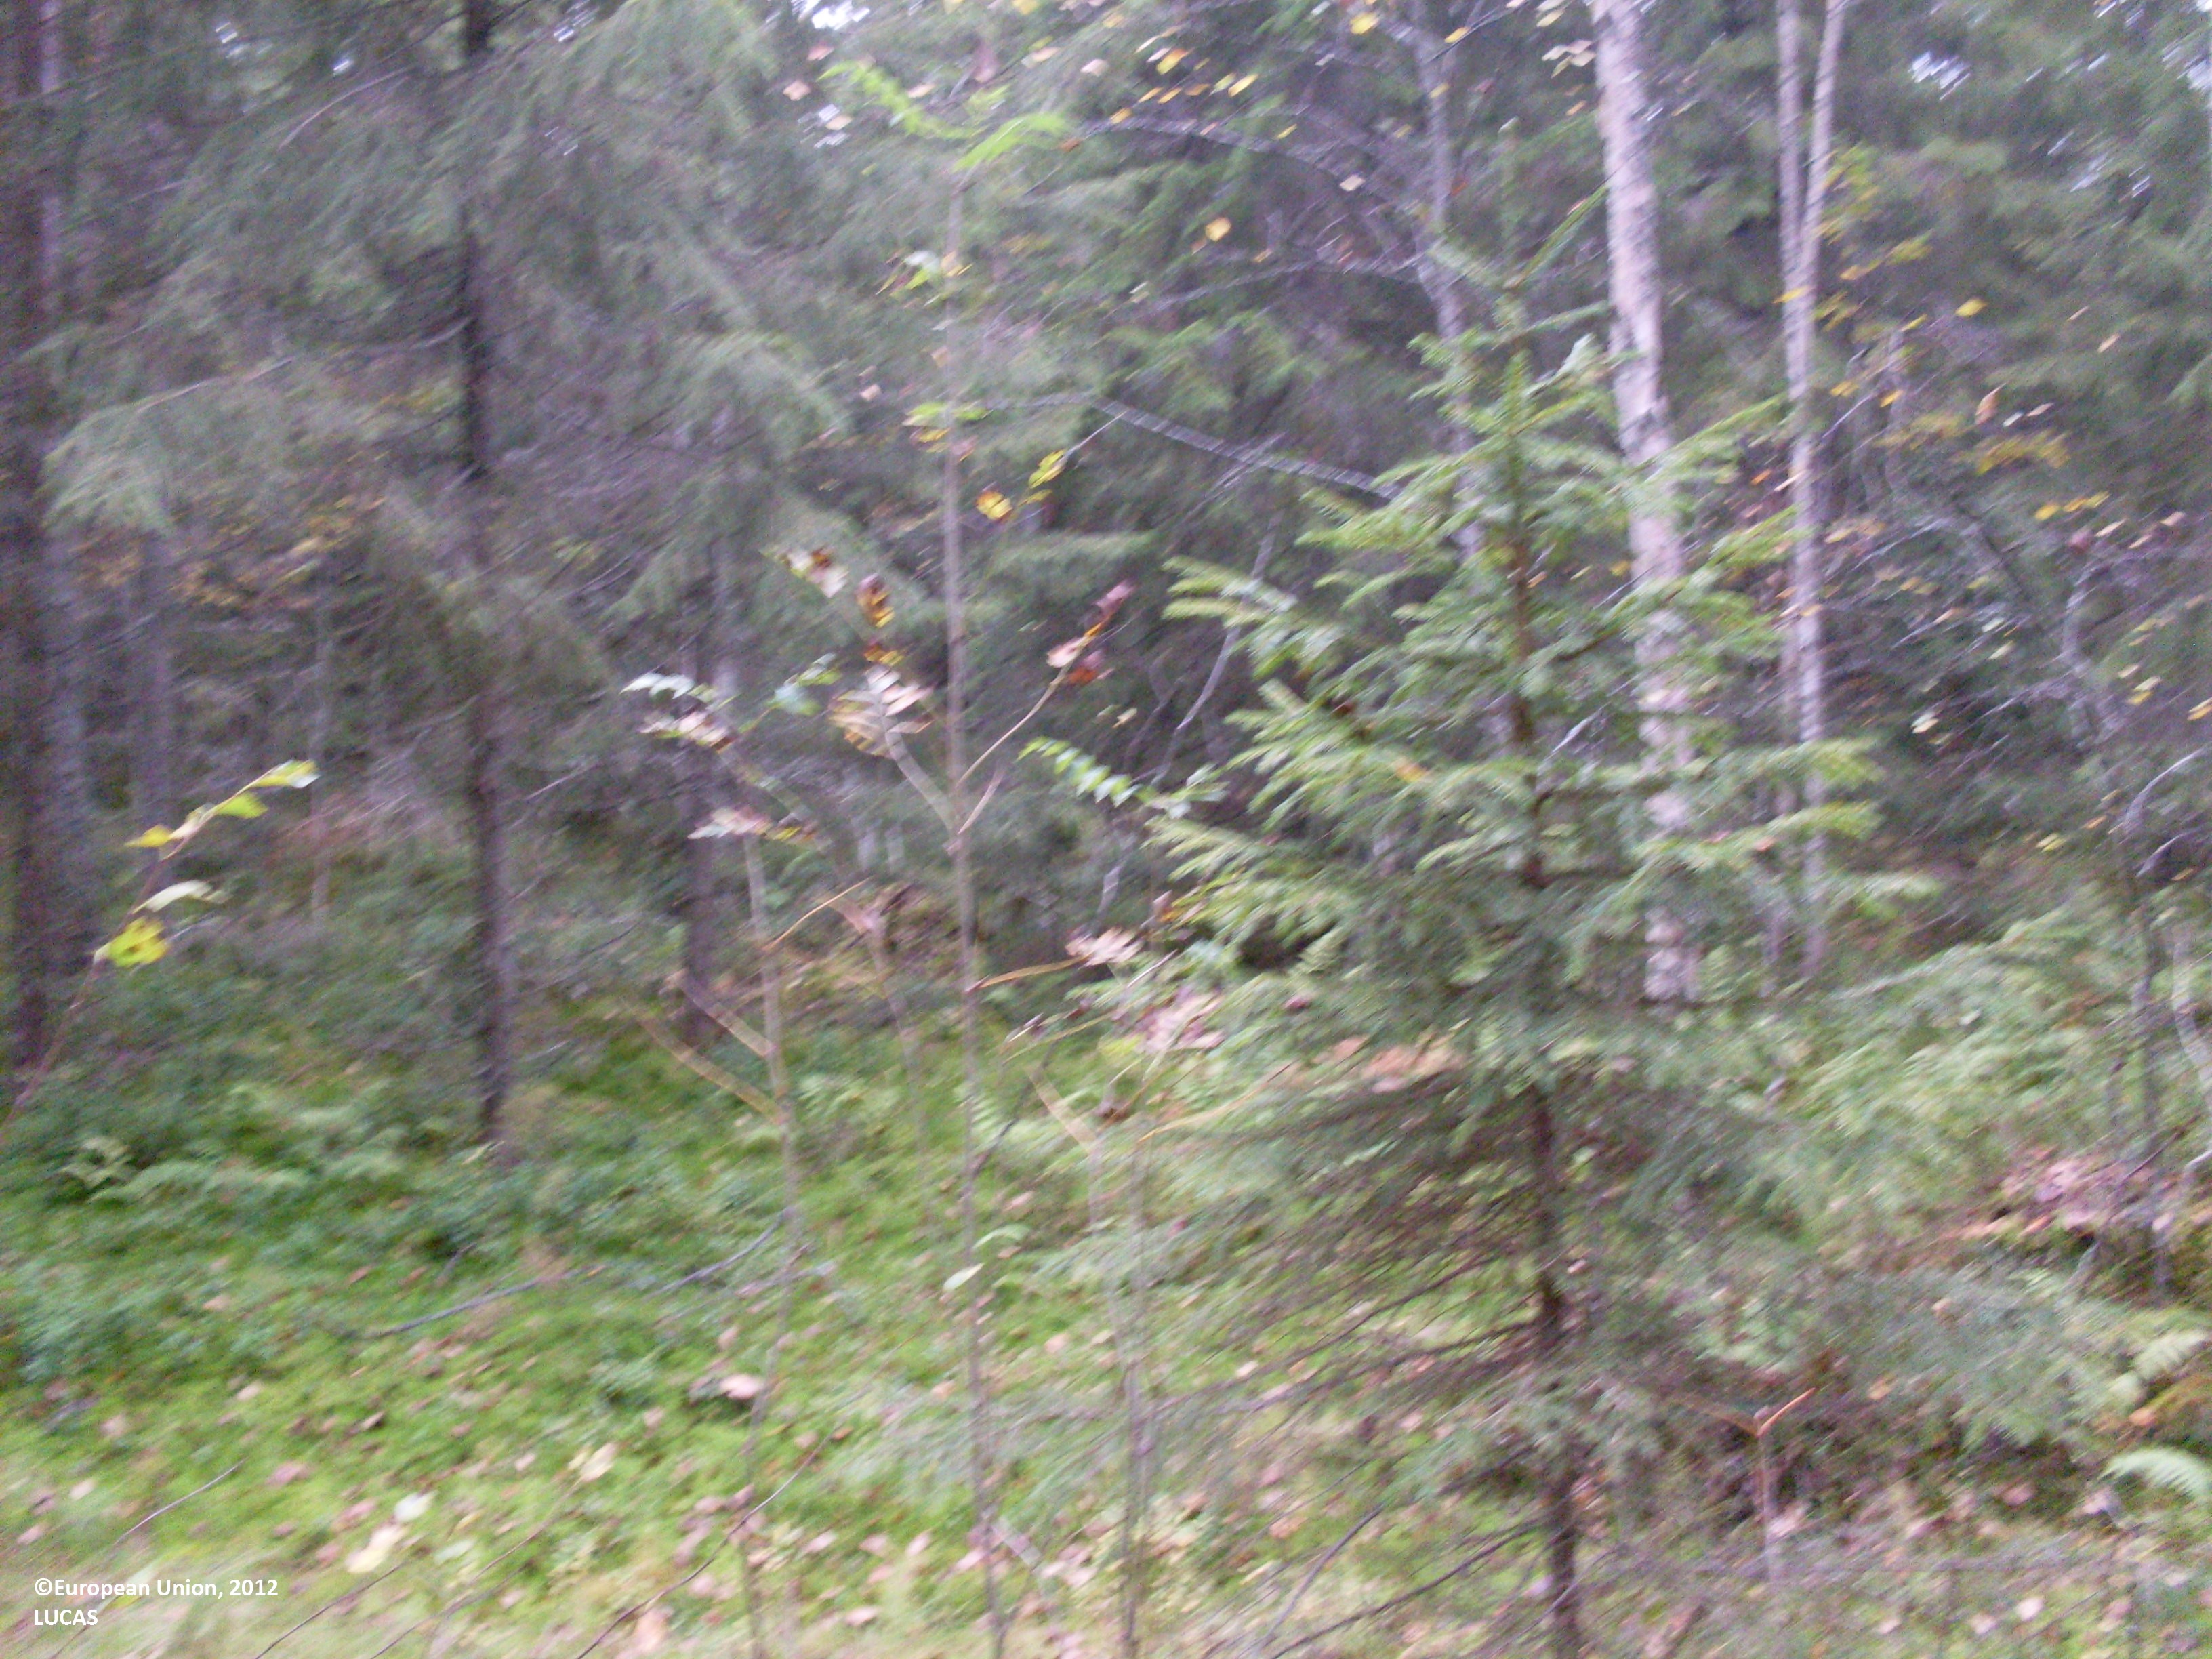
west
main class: Woodland
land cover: Spruce dominated mixed woodland
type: boreal forest
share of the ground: 50 - 75 %
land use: Forestry
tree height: > 5 m
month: September
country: FI
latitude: 64.1501
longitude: 28.3684
